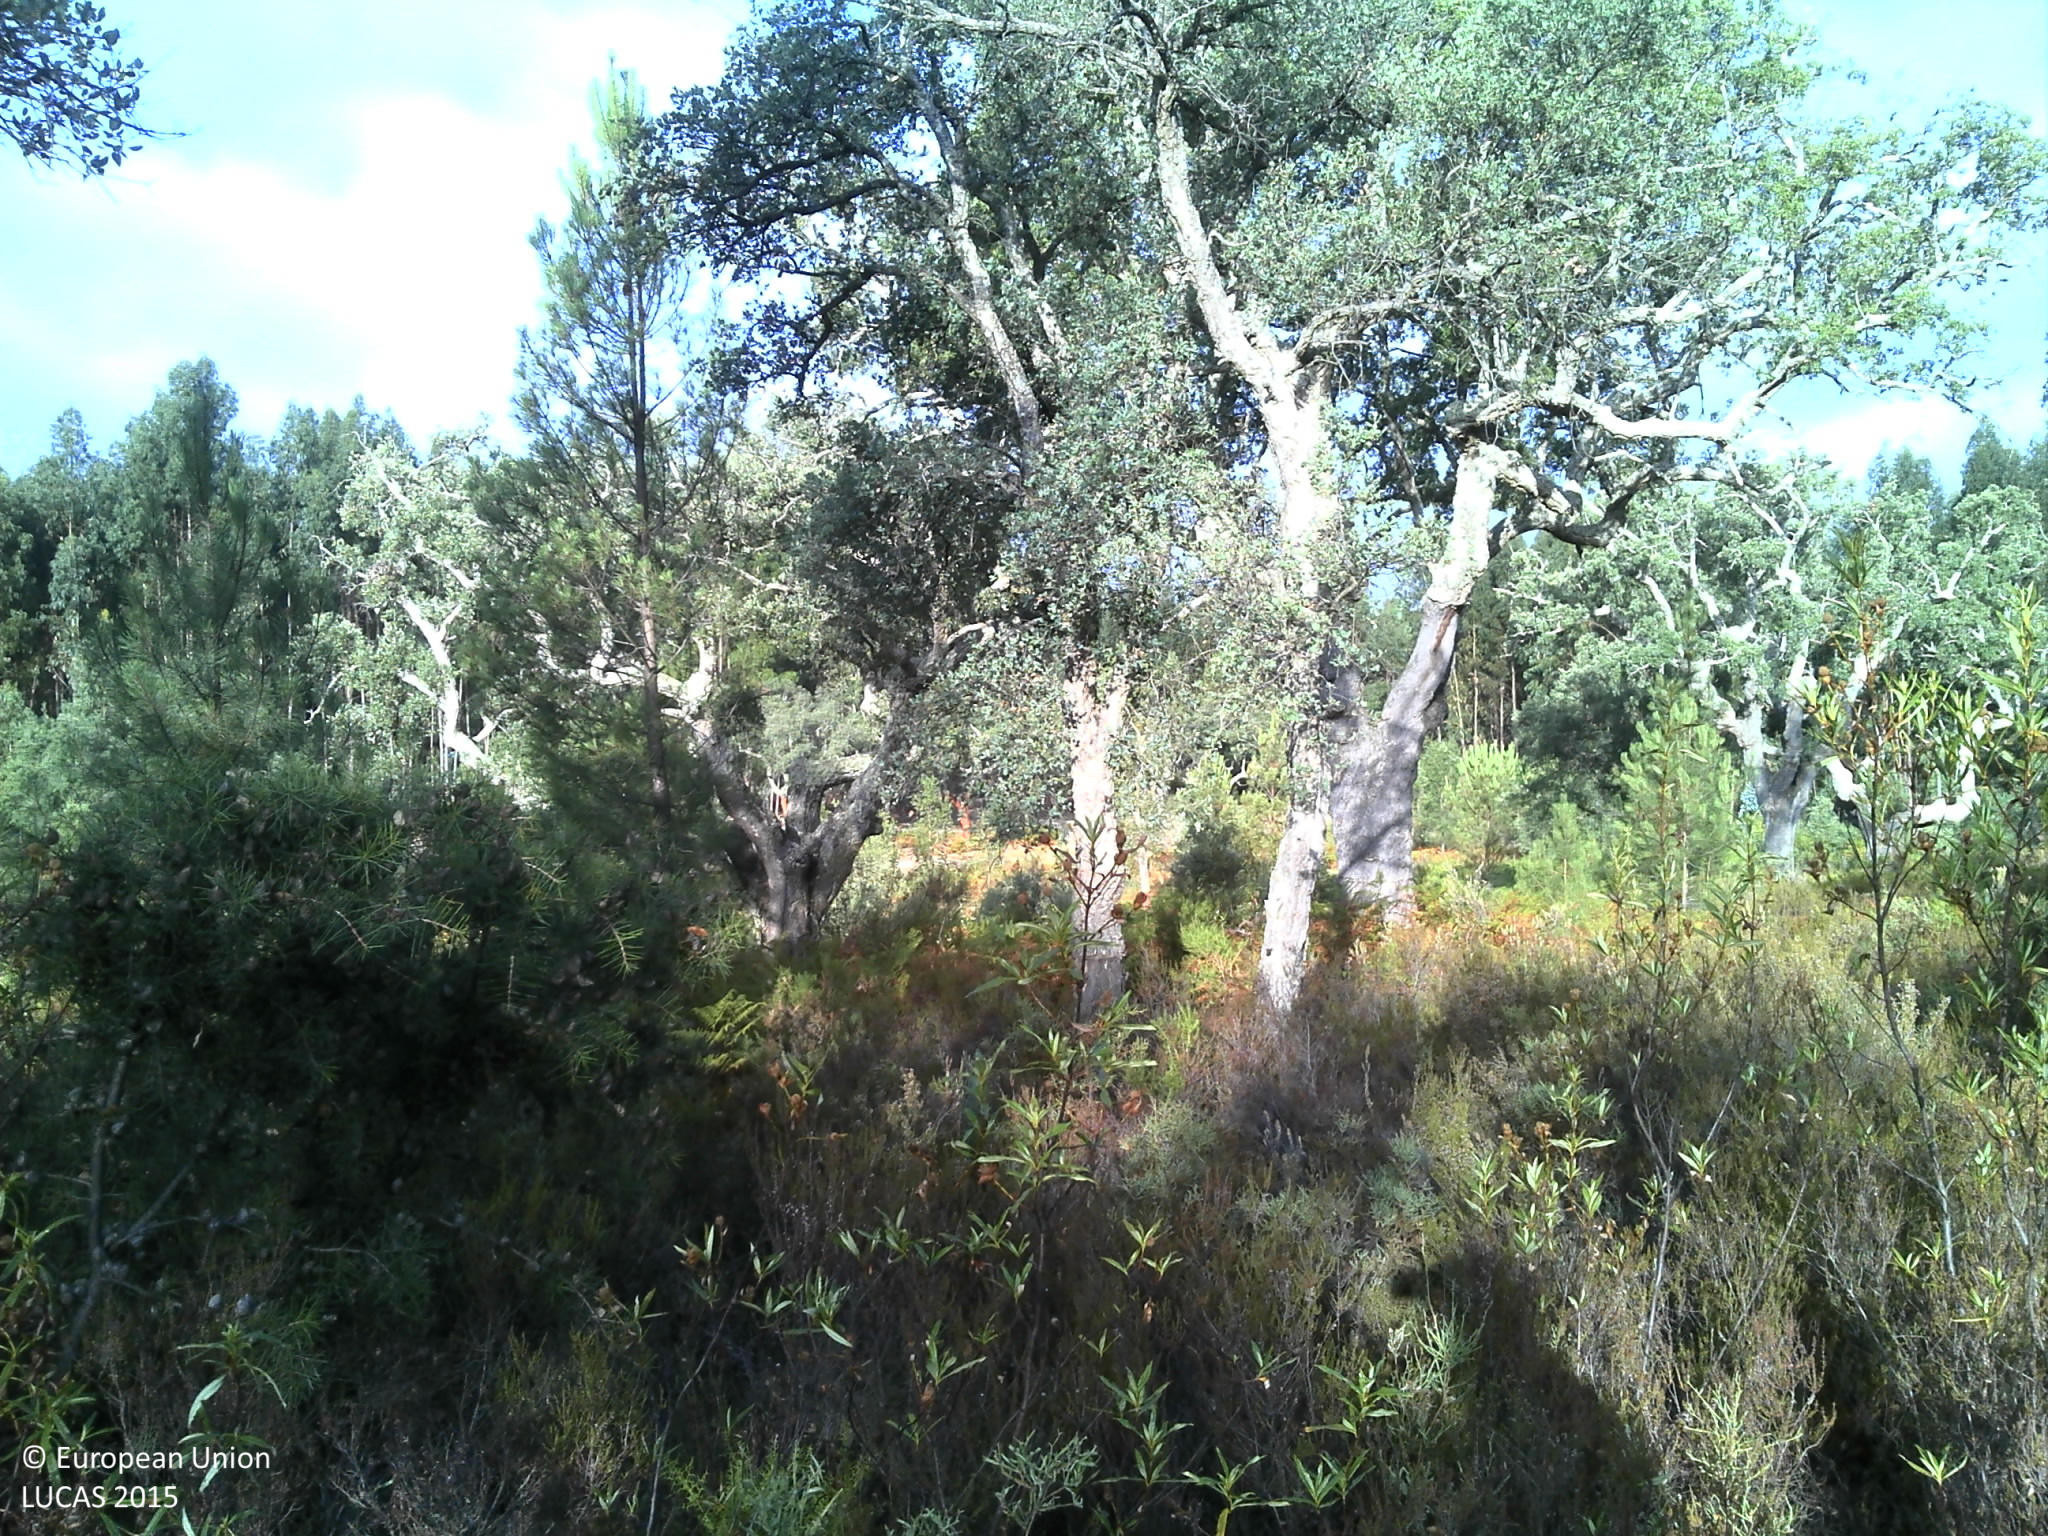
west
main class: Woodland
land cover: Broadleaved woodland
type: broadleaved evergreen forest
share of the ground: 10 - 25 %
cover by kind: shrubs 85 %, broadleaved forest trees 15 %
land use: Forestry
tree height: > 5 m
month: July
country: PT
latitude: 39.4175
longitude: -7.9080
